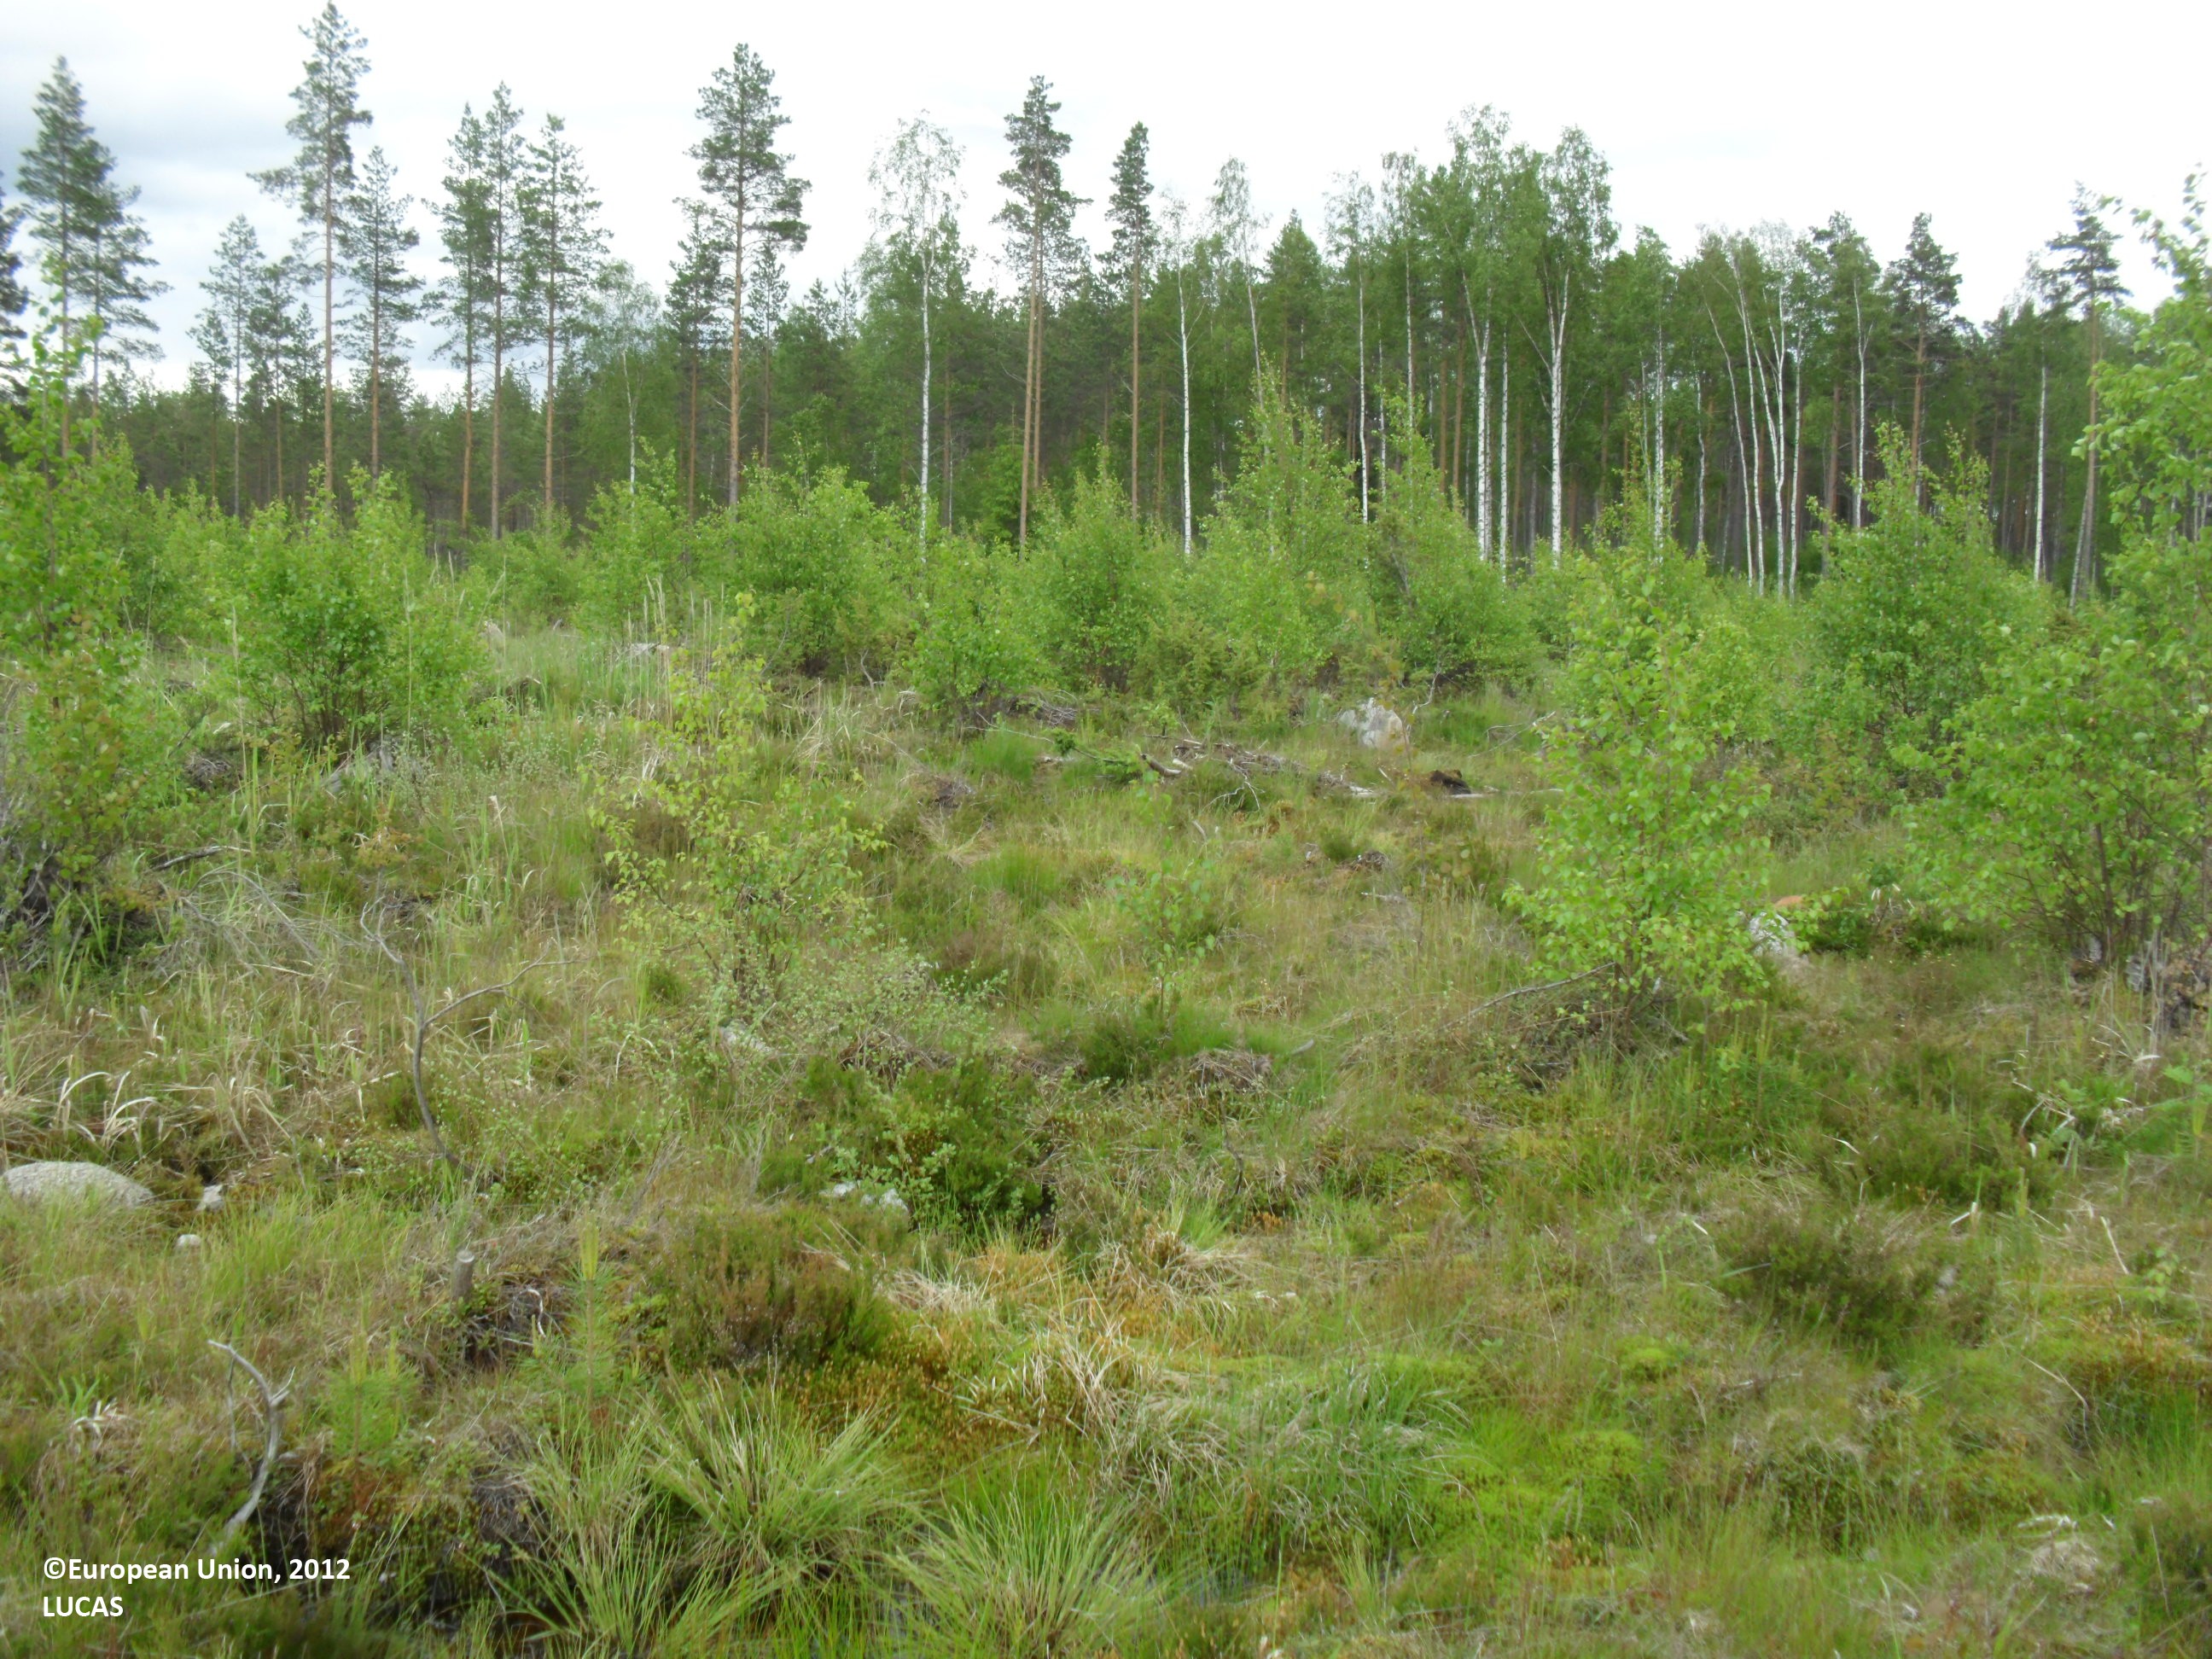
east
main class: Grassland
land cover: Grassland with sparse tree/shrub cover
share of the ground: > 75 %
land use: Forestry
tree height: < 5 m
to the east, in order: Grassland with sparse tree/shrub cover; Spontaneously vegetated surfaces; Other mixed woodland; Ditches and canals; Pine dominated coniferous woodland; Ditches and canals; Pine dominated coniferous woodland
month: June
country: FI
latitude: 63.2005
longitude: 22.9988
